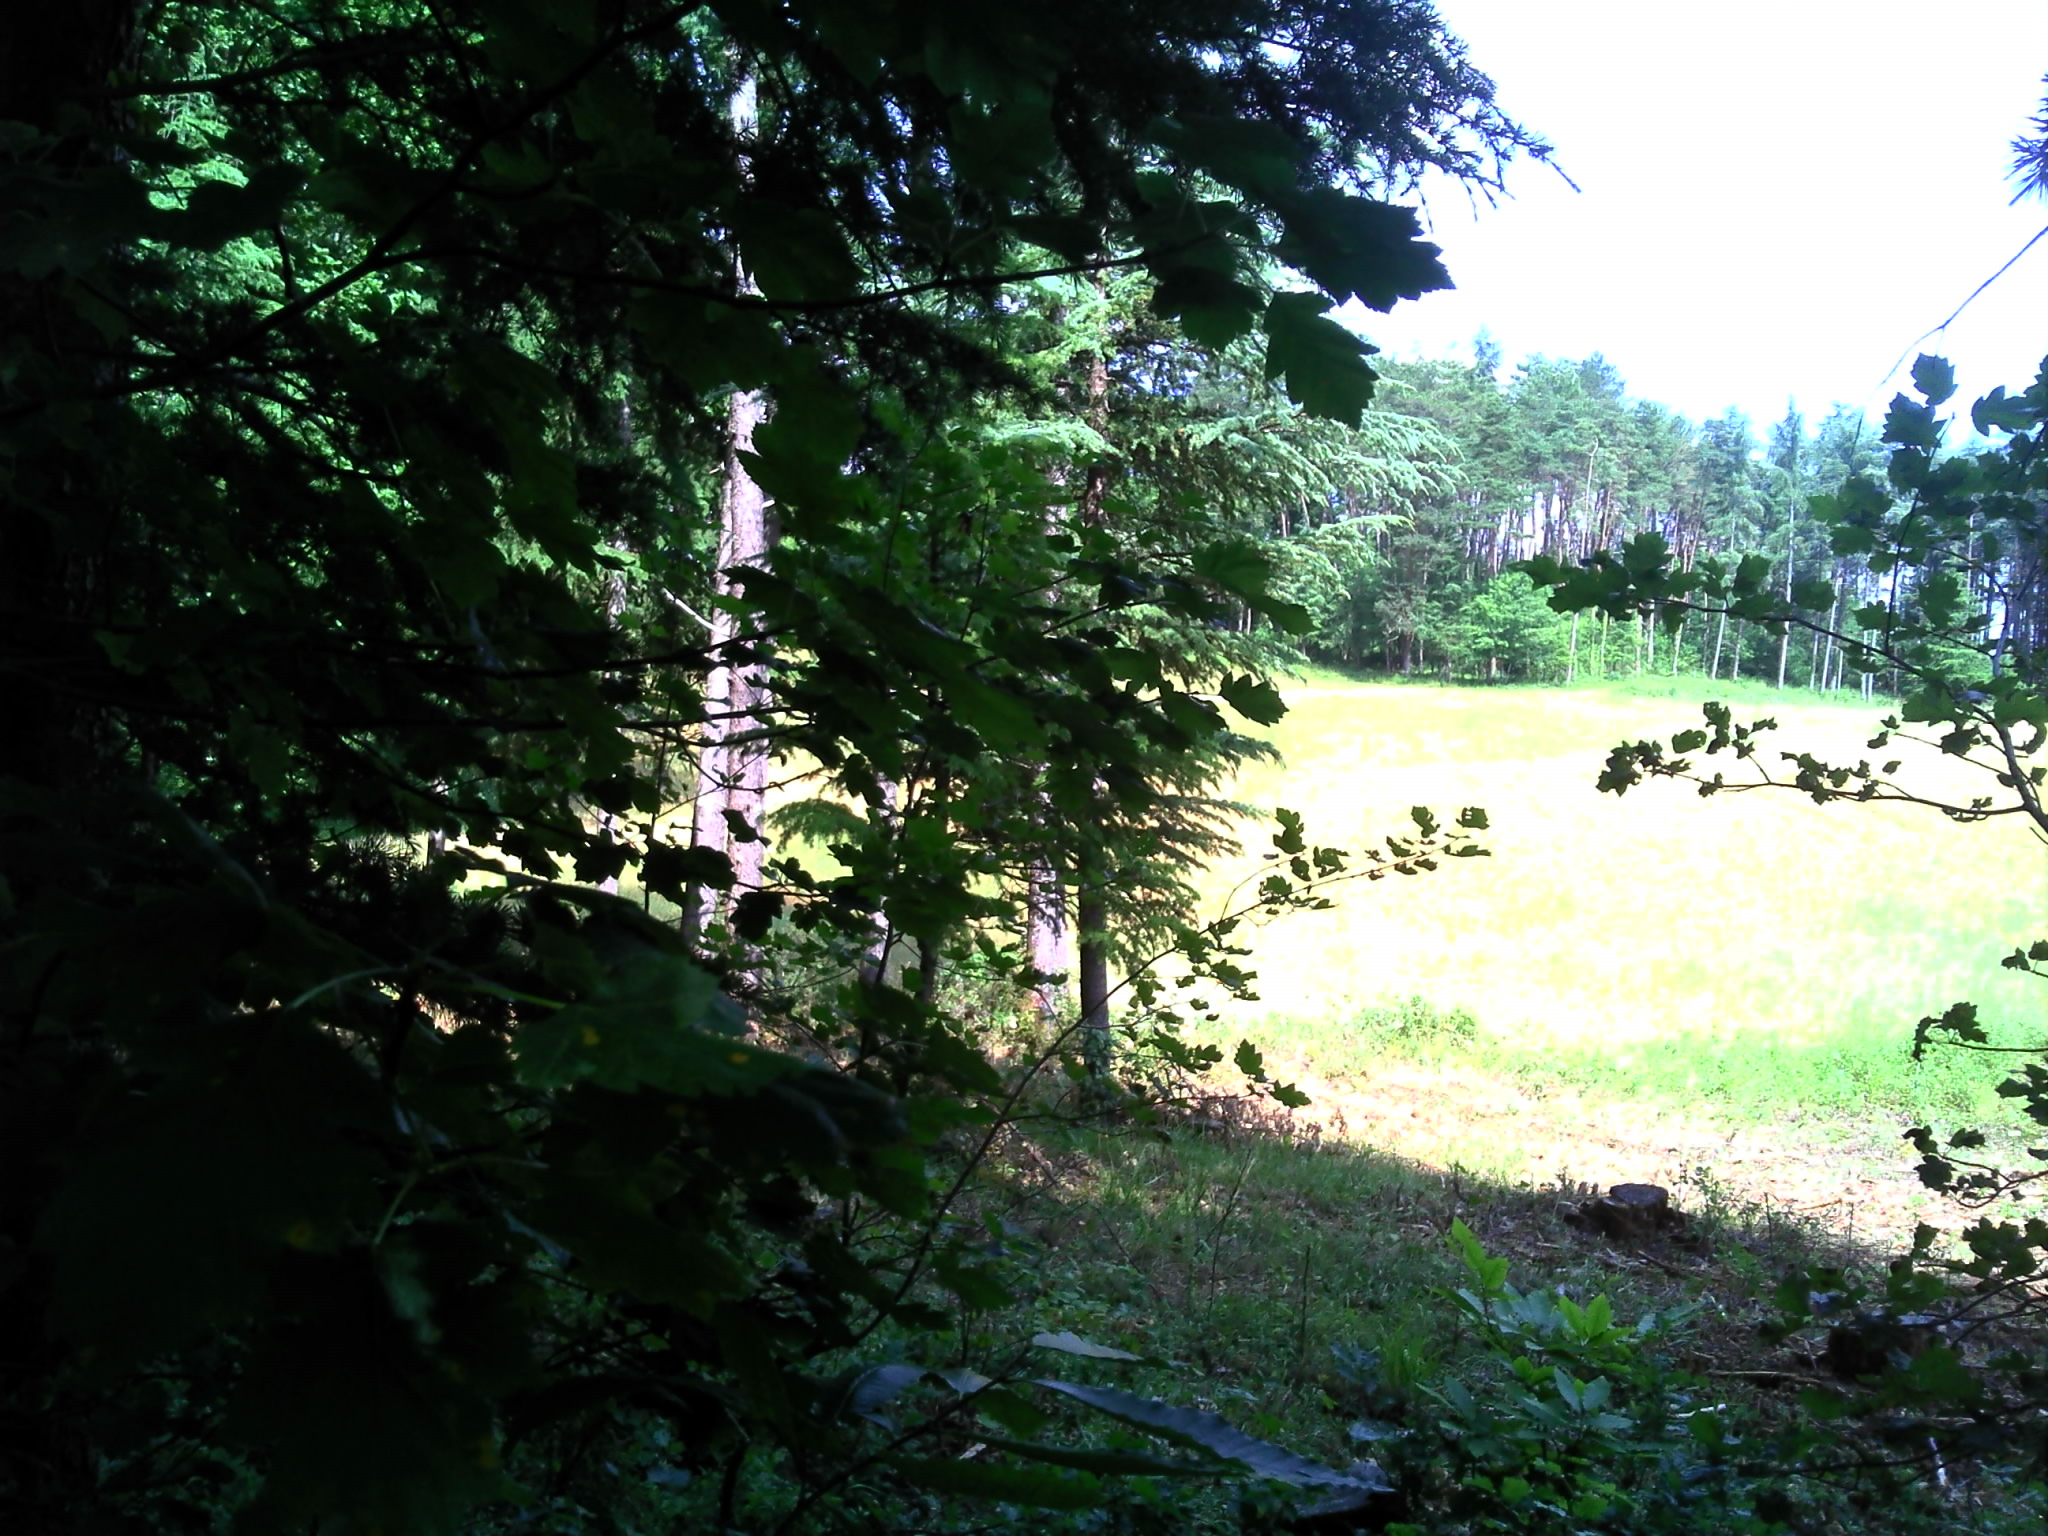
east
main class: Woodland
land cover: Broadleaved woodland
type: acidophilous oak and oak-birch forest
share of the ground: > 75 %
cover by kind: broadleaved forest trees 80 %, herbaceous plants 10 %, coniferous forest trees 5 %, shrubs 5 %
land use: Semi-natural and natural areas not in use
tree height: > 5 m
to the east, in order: Broadleaved woodland; Grassland without tree/shrub cover; Rye; Spruce dominated coniferous woodland; Artificial constructions in urban areas
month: June
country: FR
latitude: 44.4500
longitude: 1.6679
